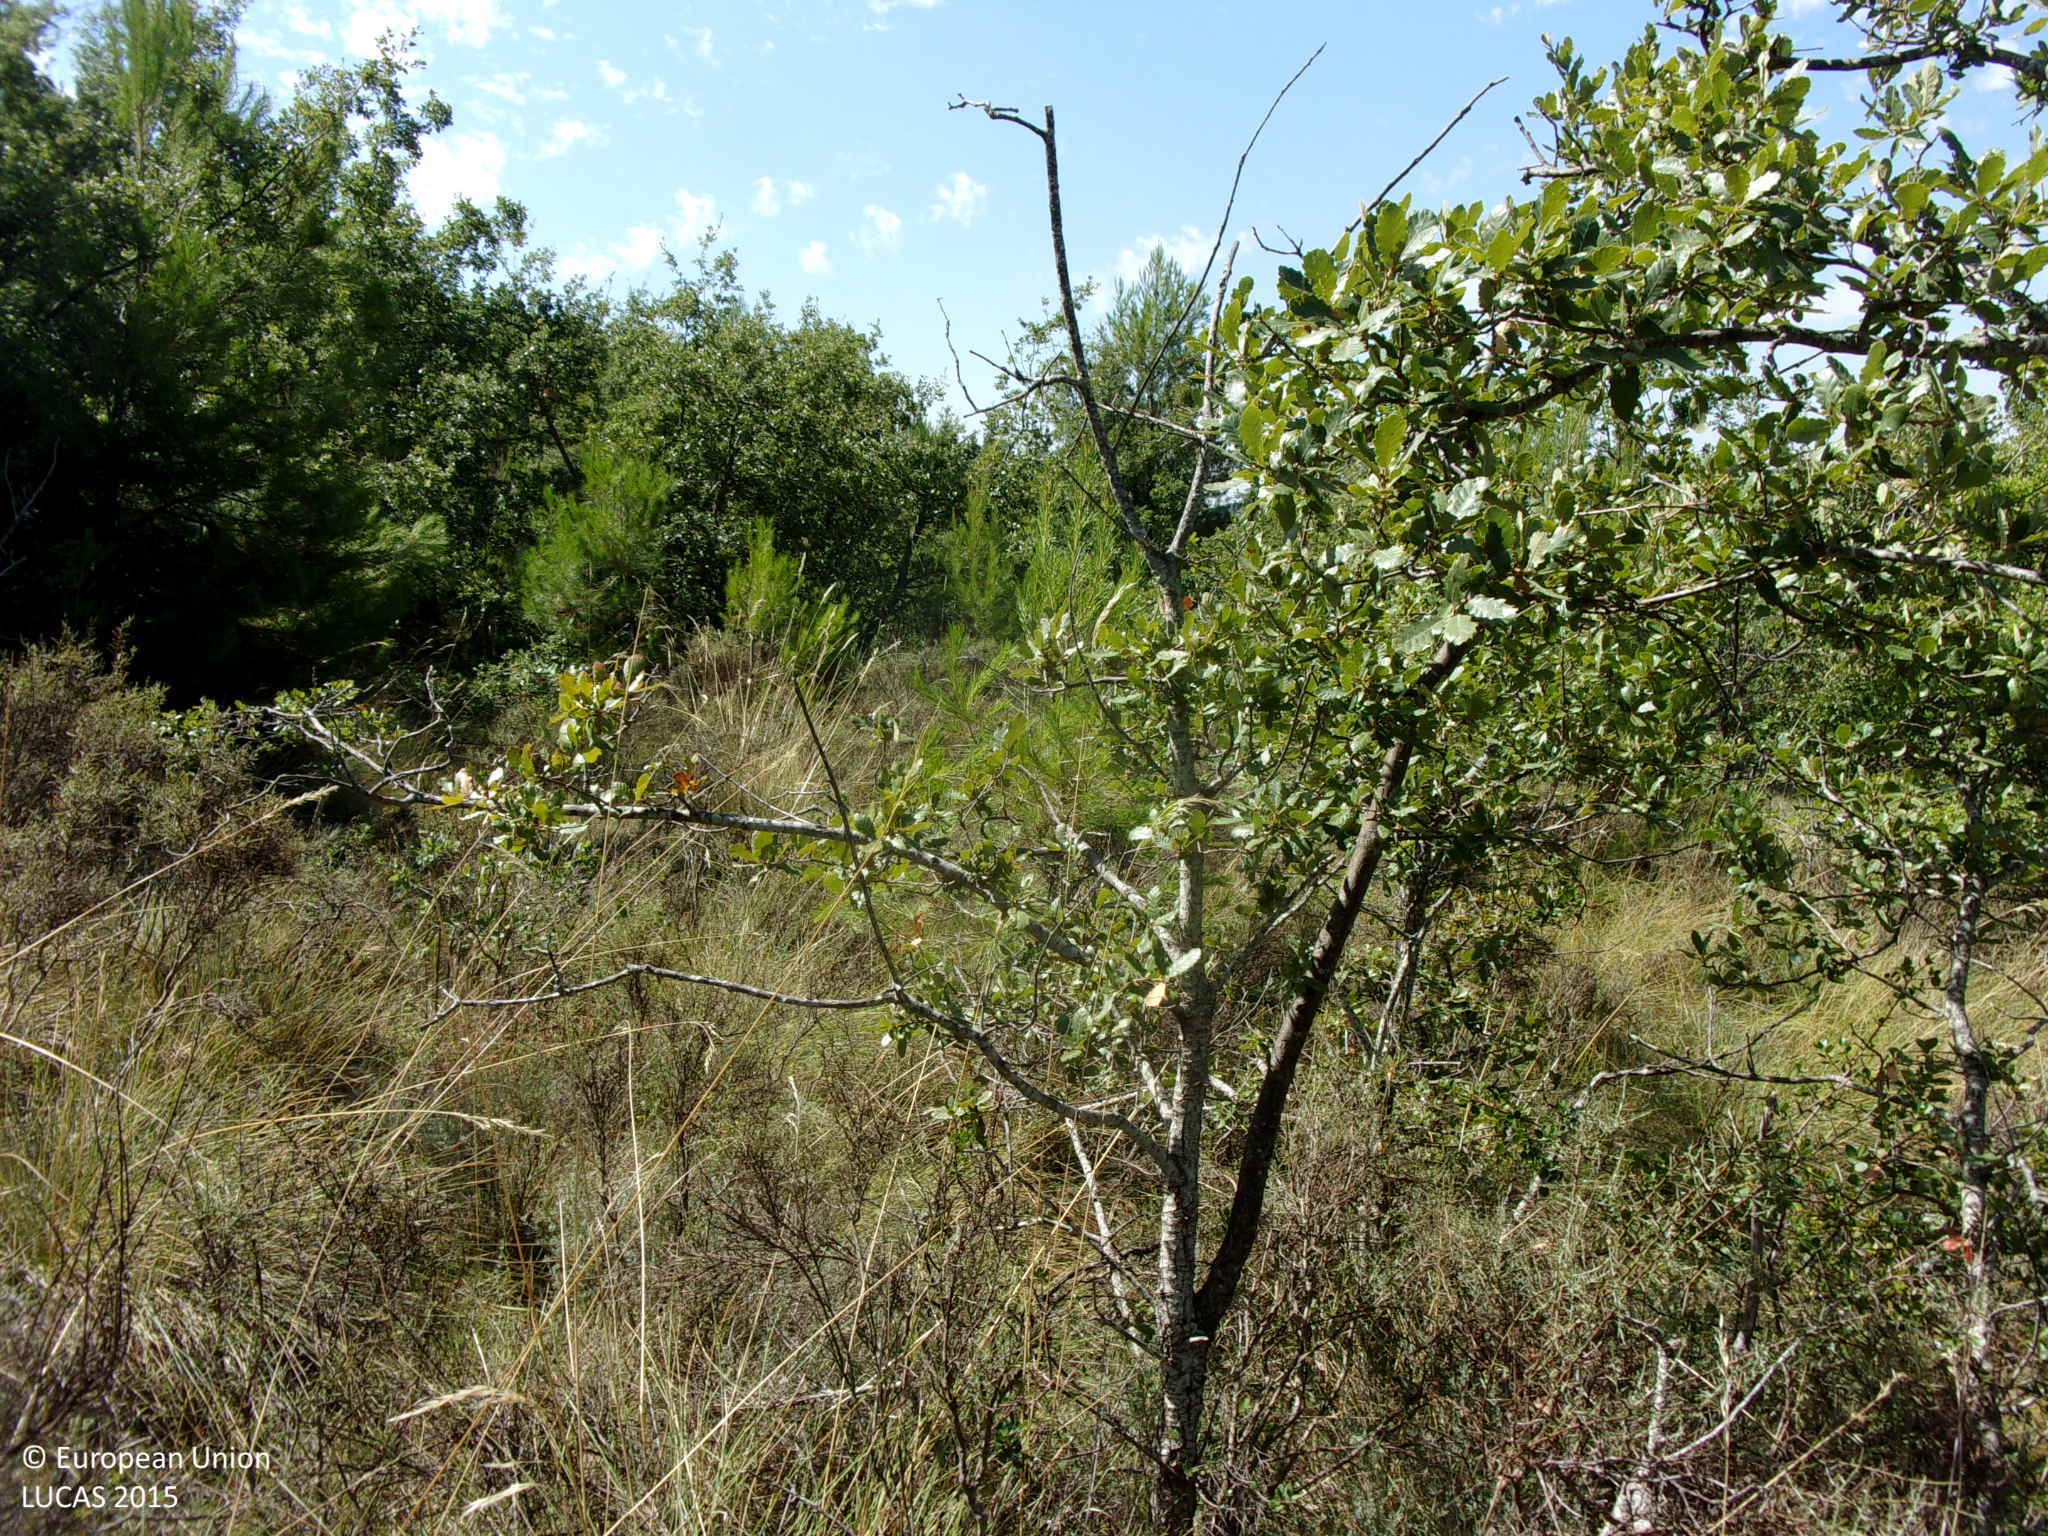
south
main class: Woodland
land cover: Broadleaved woodland
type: thermophilous deciduous forest
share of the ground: 25 - 50 %
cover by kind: broadleaved forest trees 40 %, shrubs 40 %, coniferous forest trees 10 %, herbaceous plants 10 %
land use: Forestry
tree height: < 5 m
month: August
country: ES
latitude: 42.4135
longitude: -1.1987
